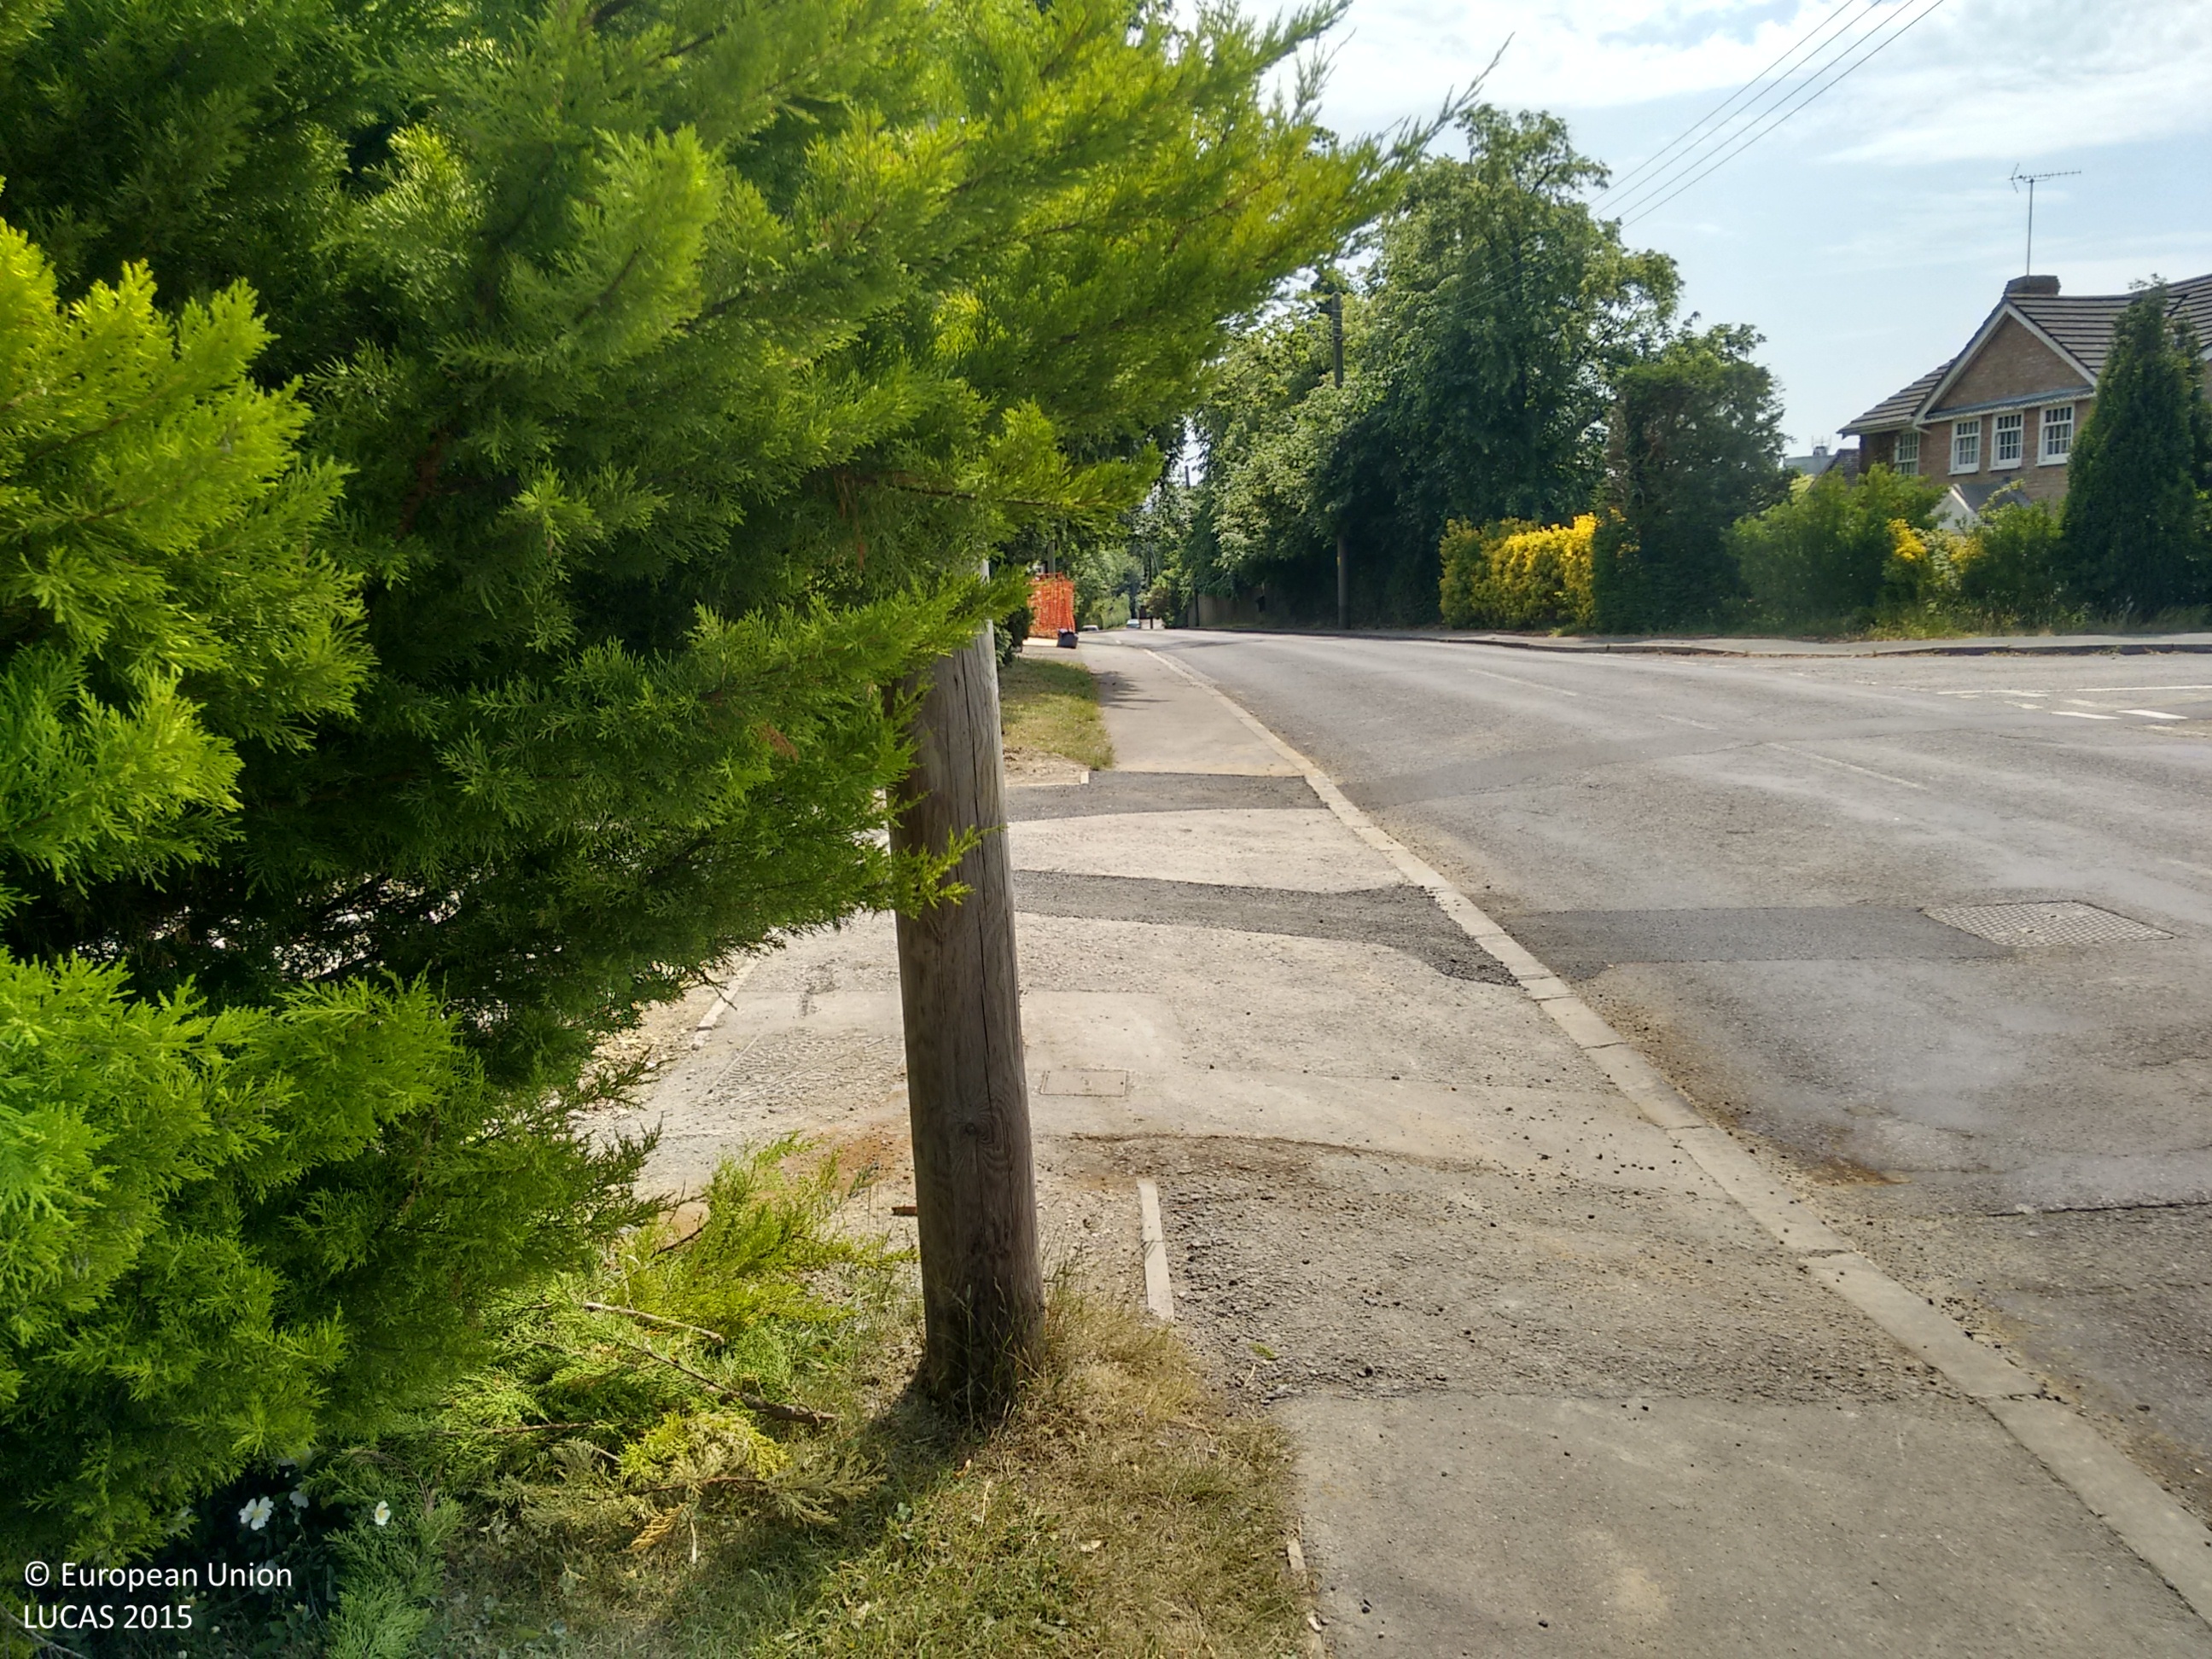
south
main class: Grassland
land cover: Grassland with sparse tree/shrub cover
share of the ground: > 75 %
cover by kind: herbaceous plants 85 %, shrubs 10 %, broadleaved forest trees 5 %
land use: Residential
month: July
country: GB
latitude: 50.9466
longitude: -0.1256
